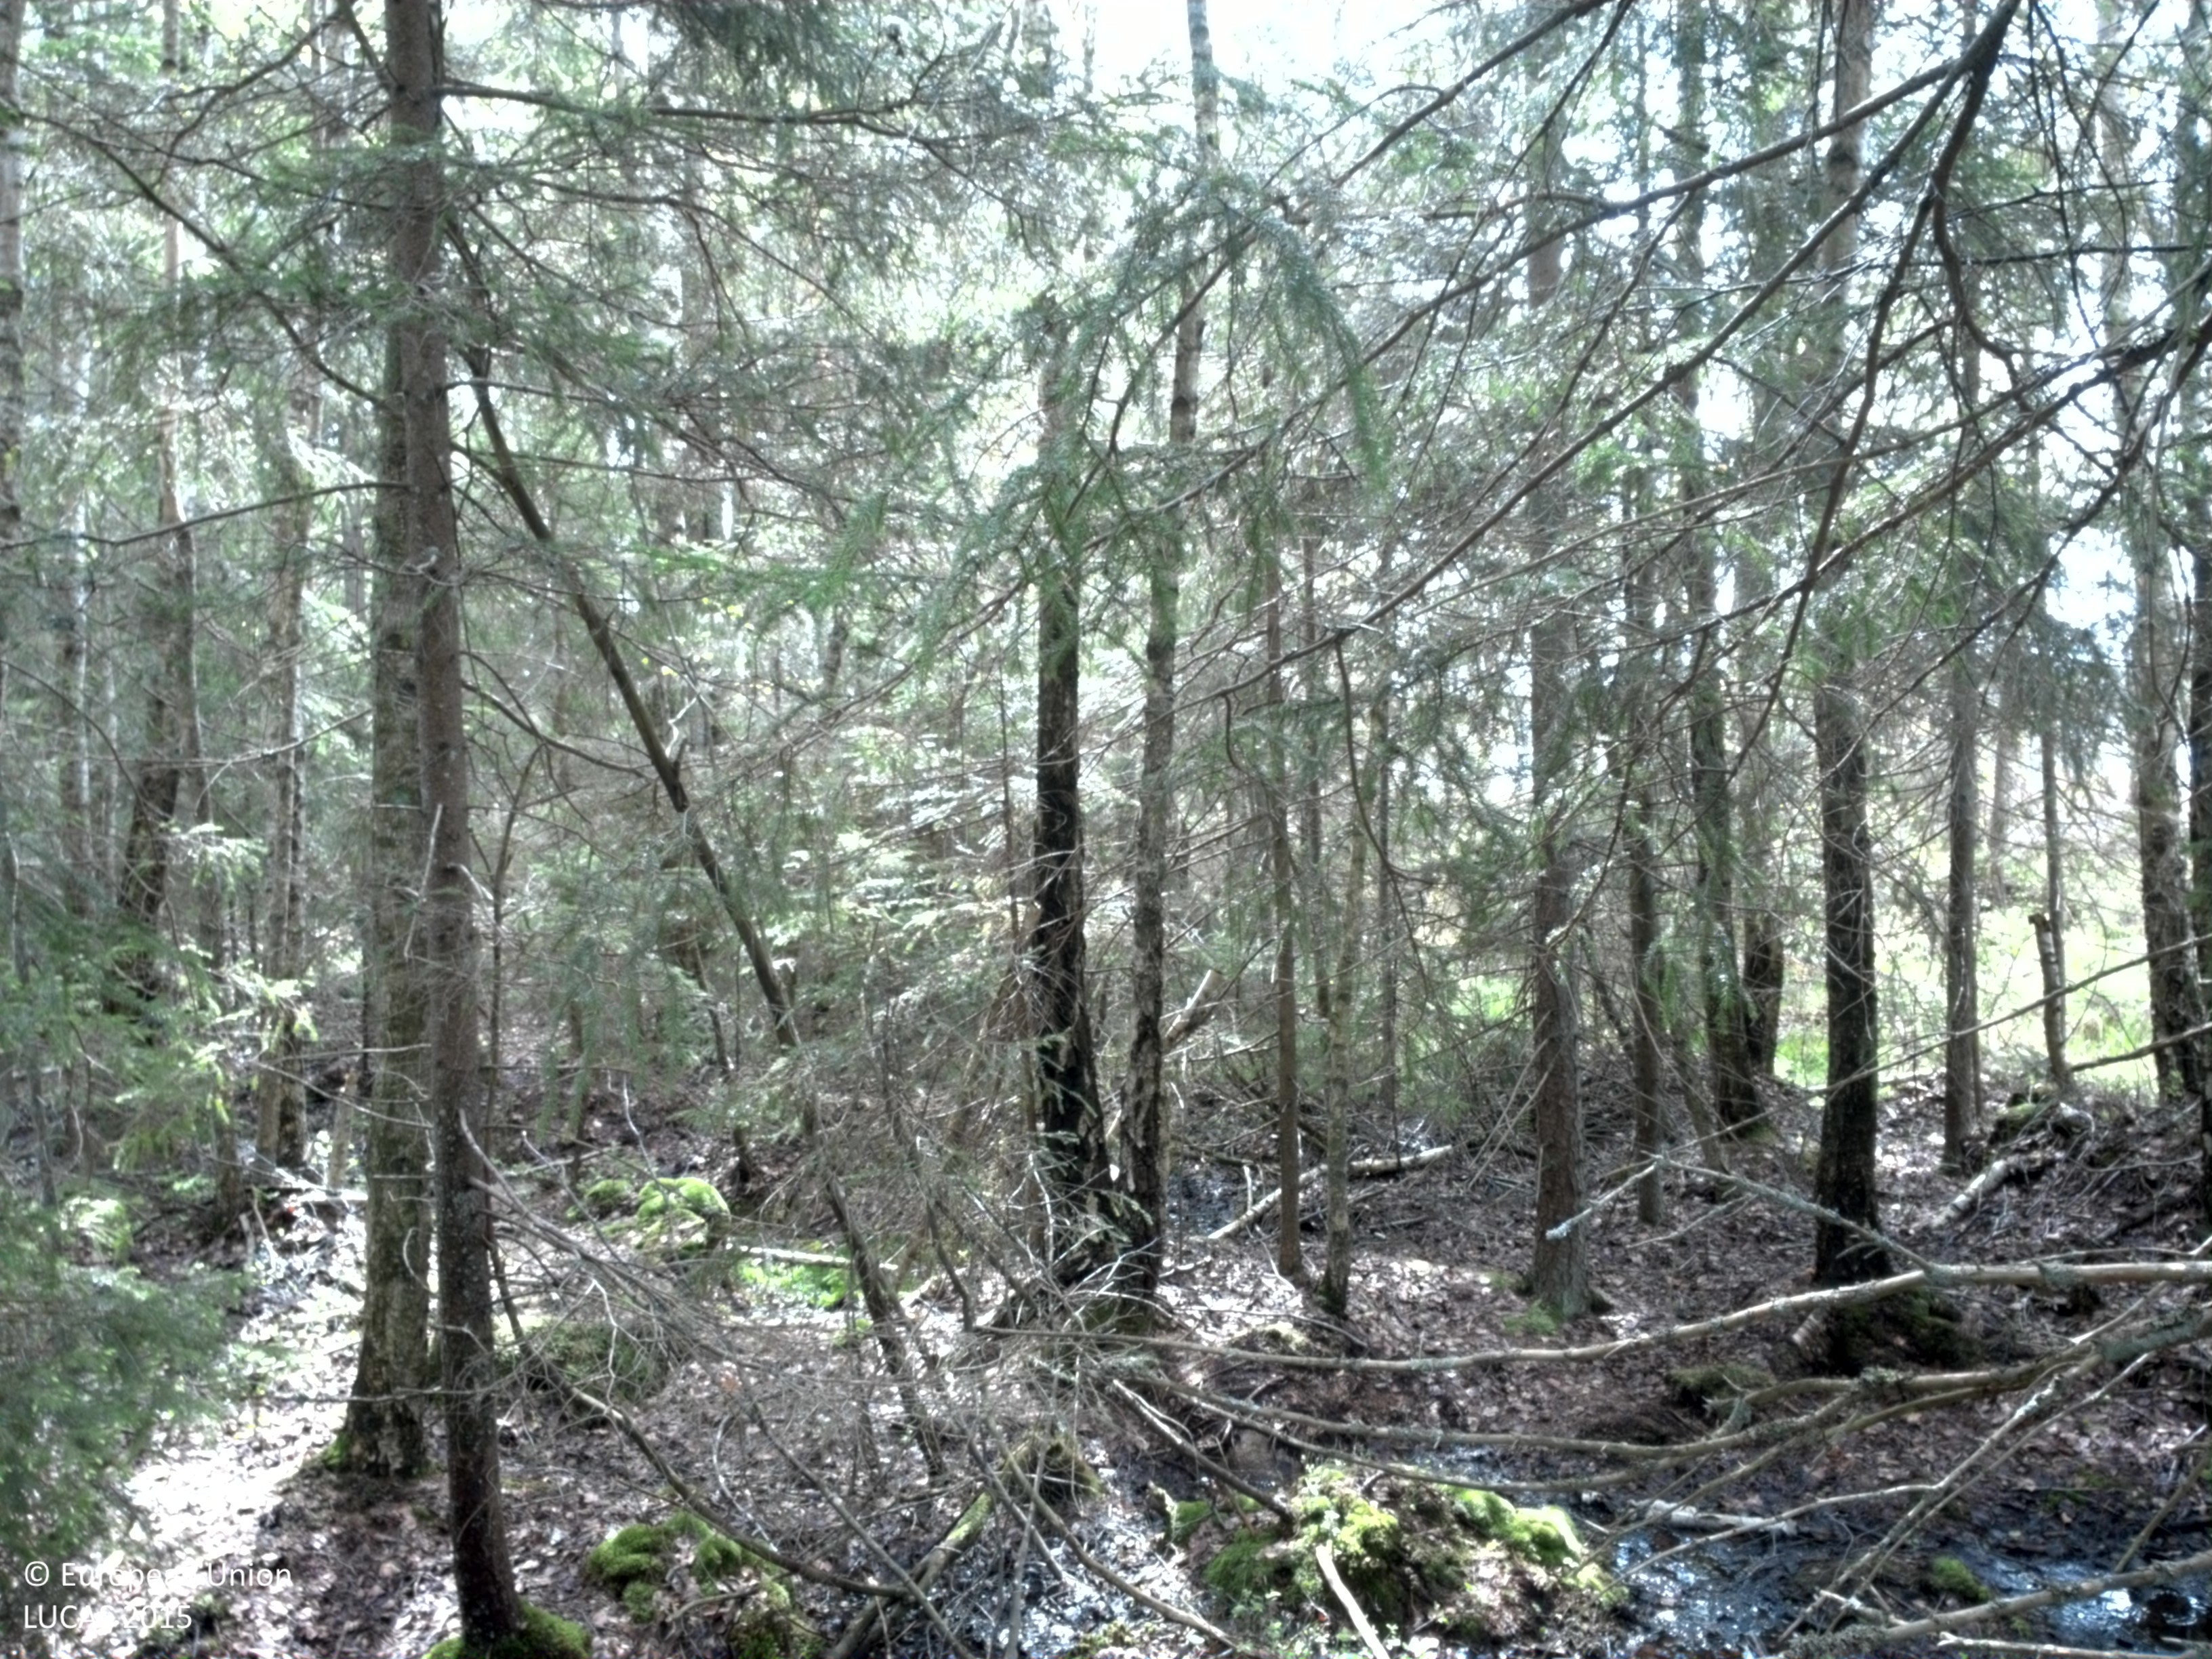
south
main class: Woodland
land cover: Spruce dominated mixed woodland
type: boreal forest
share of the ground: > 75 %
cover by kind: broadleaved forest trees 50 %, coniferous forest trees 40 %, lichens and mosses 10 %
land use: Forestry
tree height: > 5 m
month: May
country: SE
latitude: 56.7908
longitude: 15.0562
